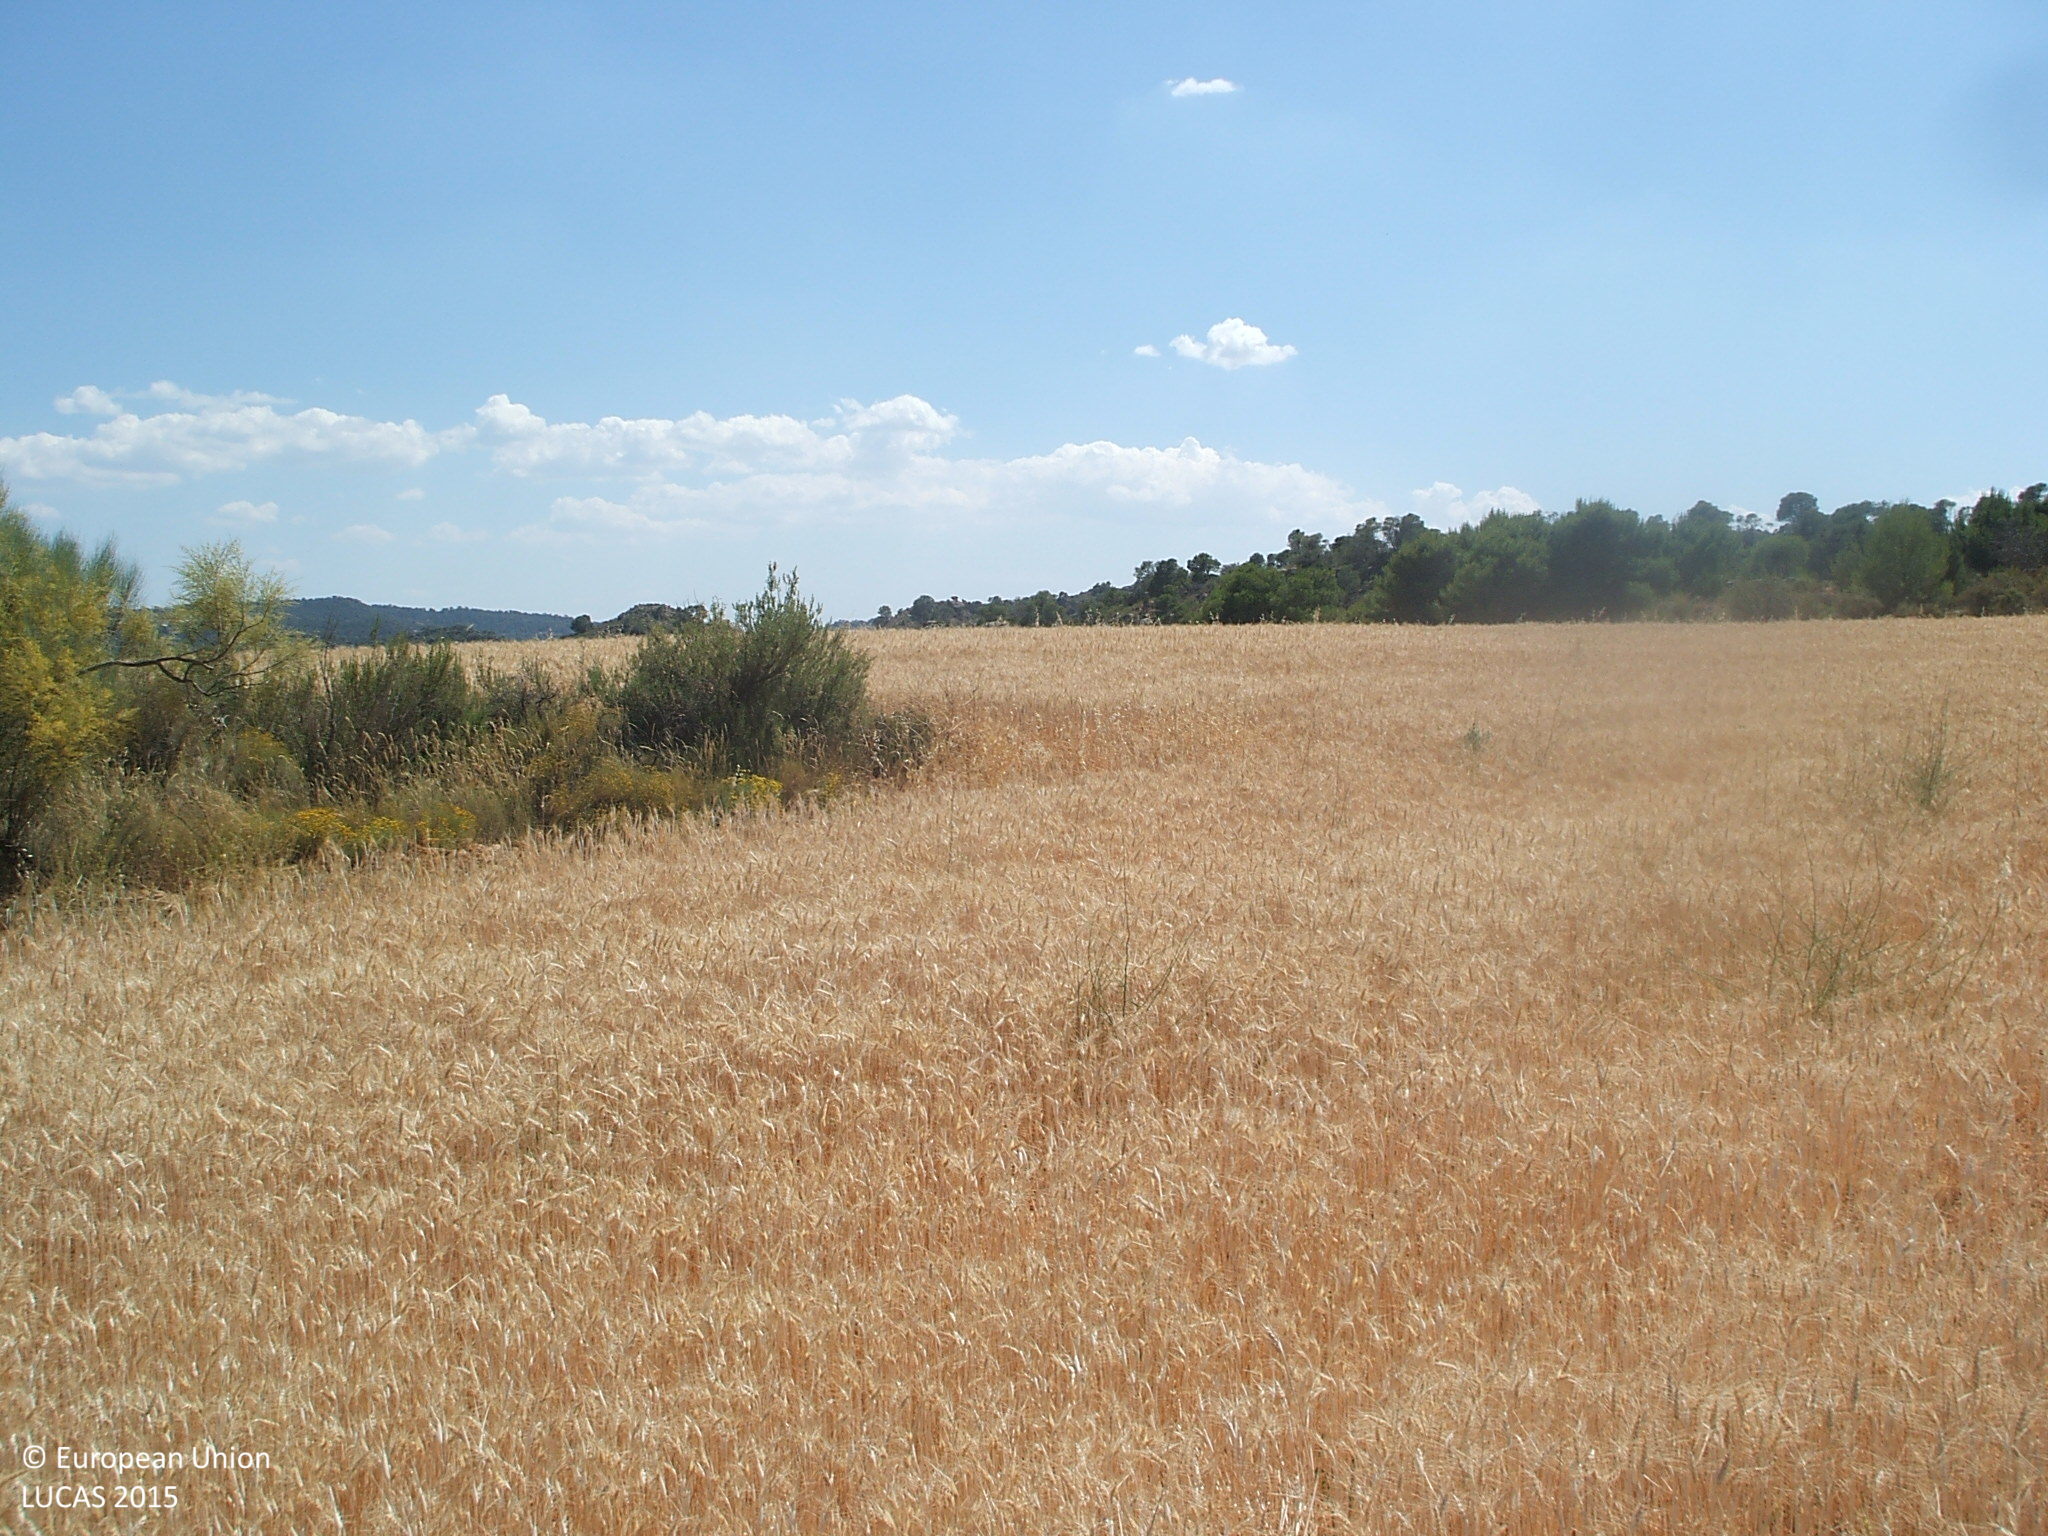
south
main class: Cropland
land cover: Common wheat
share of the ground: > 75 %
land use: Agriculture (excluding fallow land and kitchen gardens)
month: June
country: ES
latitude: 41.0955
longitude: -0.0718
